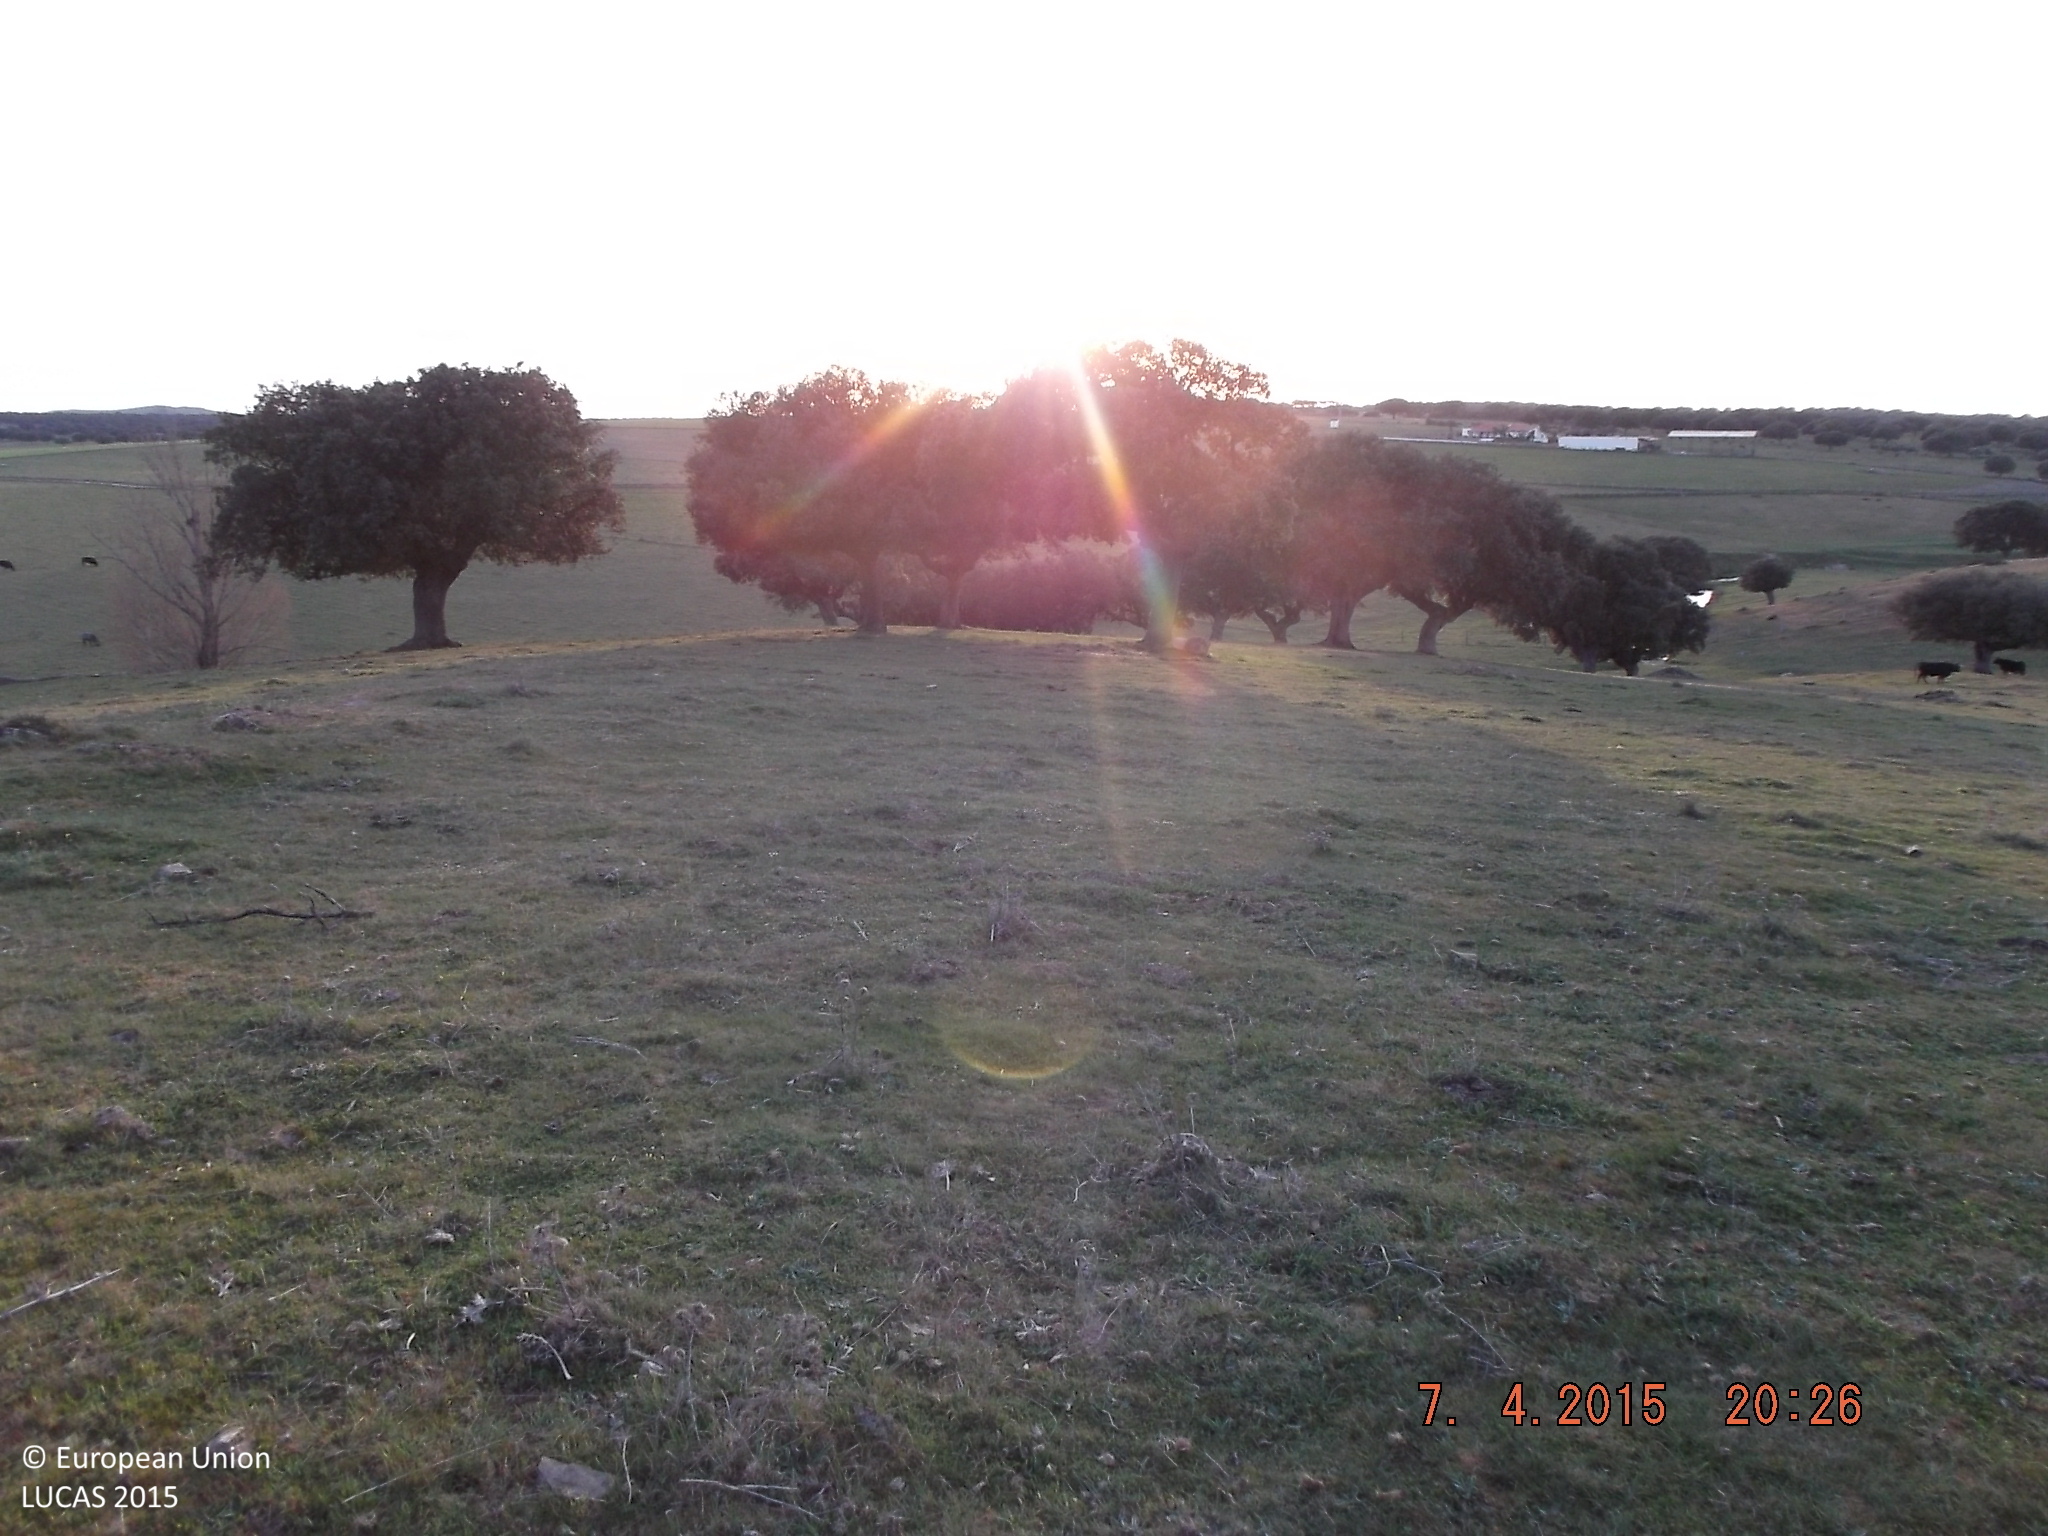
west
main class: Grassland
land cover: Grassland without tree/shrub cover
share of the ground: > 75 %
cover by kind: herbaceous plants 100 %
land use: Agriculture (excluding fallow land and kitchen gardens)
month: April
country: ES
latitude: 40.7862
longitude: -5.8752
